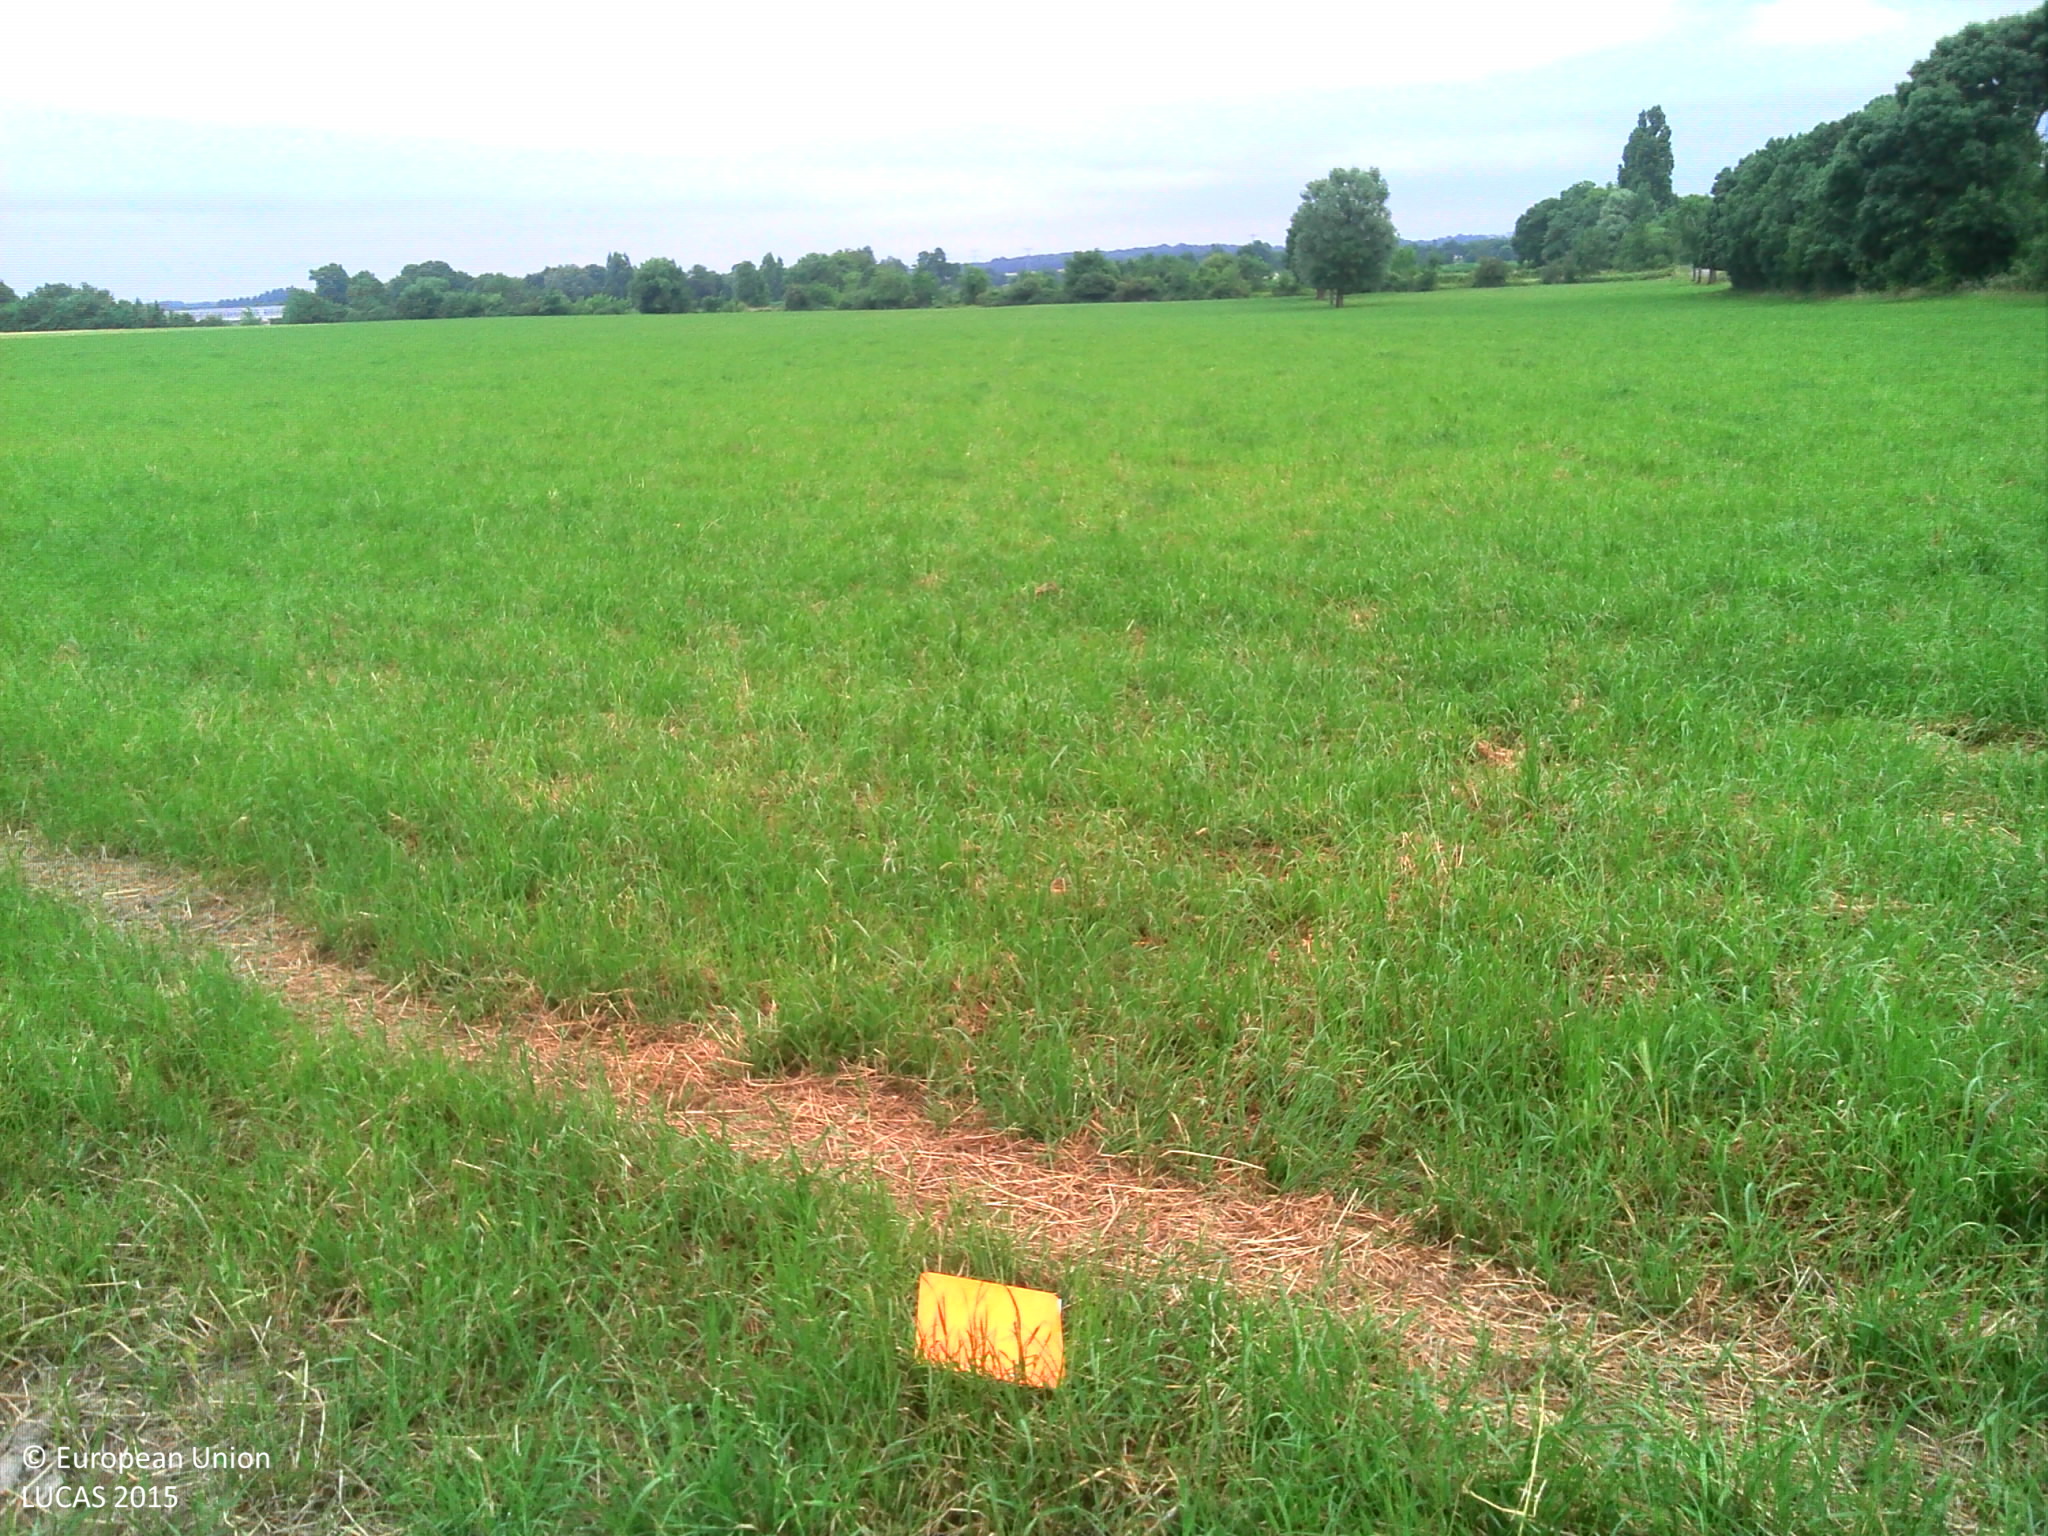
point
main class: Grassland
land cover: Grassland without tree/shrub cover
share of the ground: > 75 %
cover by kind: herbaceous plants 100 %
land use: Agriculture (excluding fallow land and kitchen gardens)
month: June
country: FR
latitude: 45.9047
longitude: -0.8682
